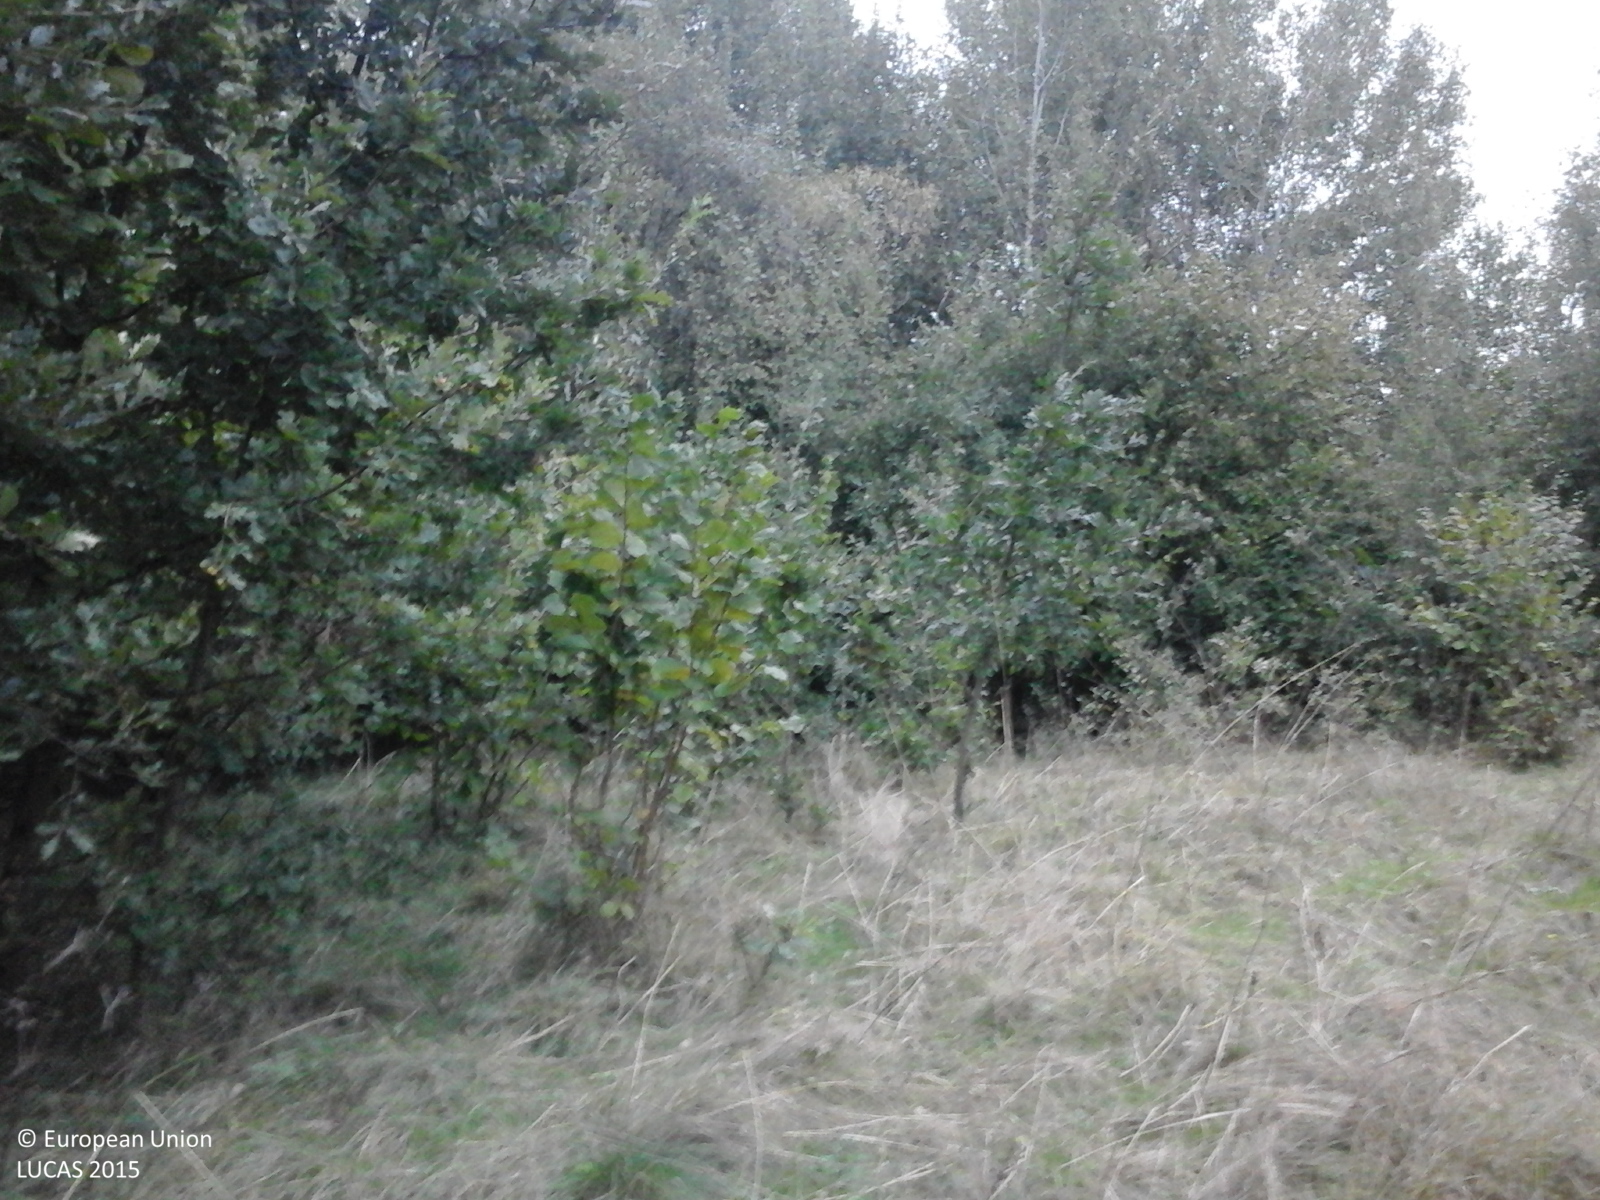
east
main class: Grassland
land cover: Grassland with sparse tree/shrub cover
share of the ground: > 75 %
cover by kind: herbaceous plants 90 %, broadleaved forest trees 5 %, shrubs 5 %
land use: Agriculture (excluding fallow land and kitchen gardens)
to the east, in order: Grassland with sparse tree/shrub cover; Broadleaved woodland; Grassland without tree/shrub cover; Tracks; Grassland without tree/shrub cover; Broadleaved woodland; Rivers and streams; Broadleaved woodland; Grassland without tree/shrub cover
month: September
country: RO
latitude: 45.8868
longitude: 23.3992
